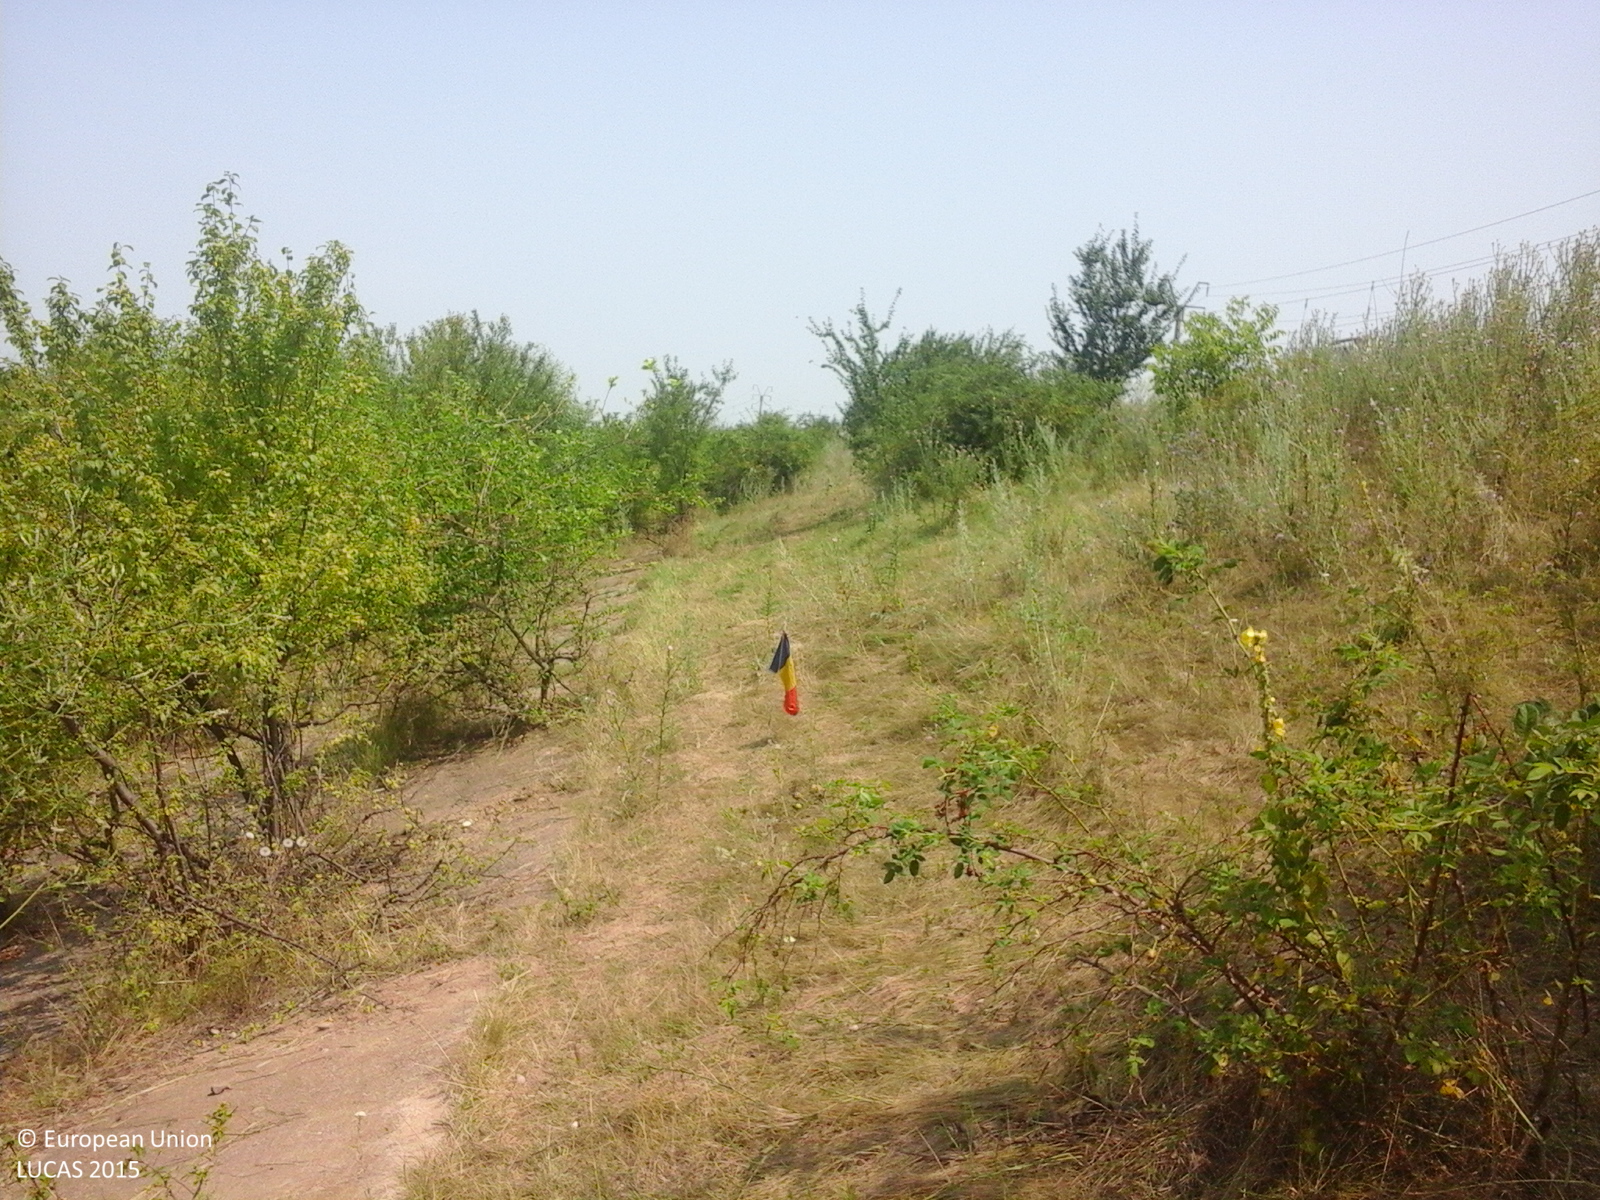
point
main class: Grassland
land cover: Grassland with sparse tree/shrub cover
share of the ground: > 75 %
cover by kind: herbaceous plants 85 %, shrubs 10 %, broadleaved forest trees 5 %
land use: Agriculture (excluding fallow land and kitchen gardens)
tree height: < 5 m
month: July
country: RO
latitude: 44.6585
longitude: 26.4733
